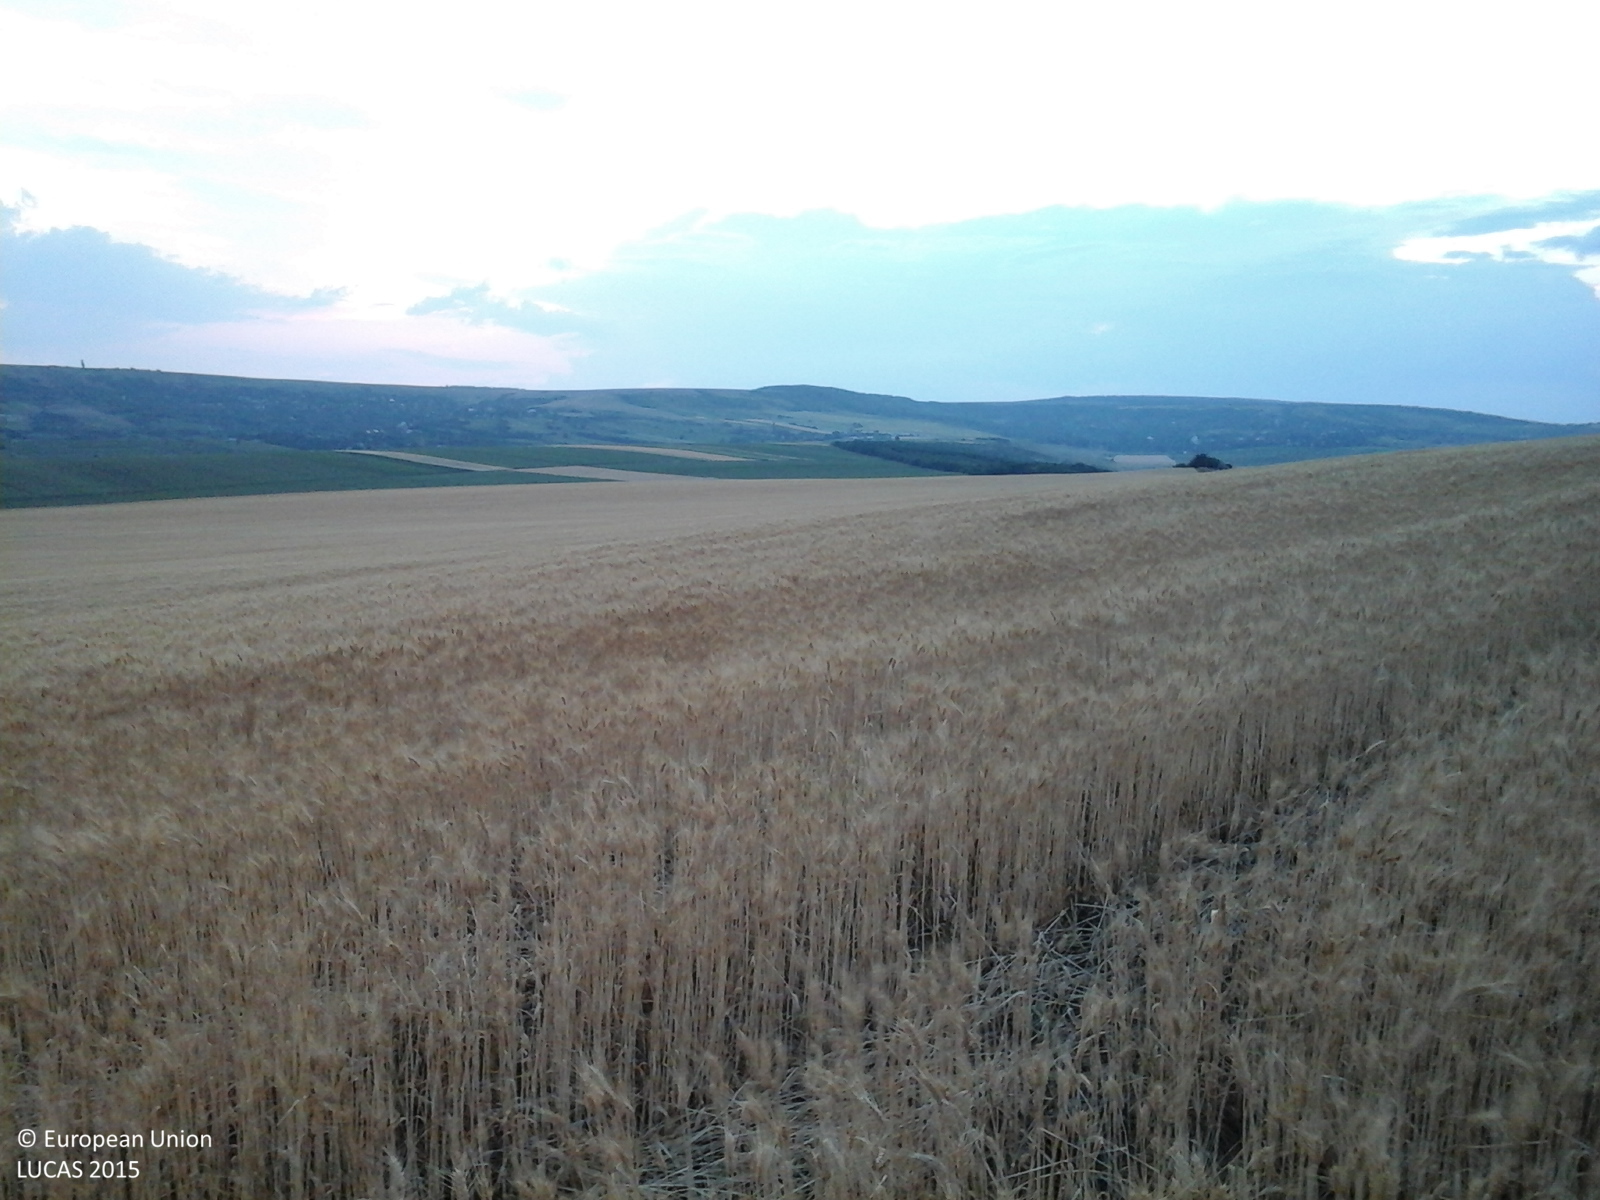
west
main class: Cropland
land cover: Common wheat
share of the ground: > 75 %
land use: Agriculture (excluding fallow land and kitchen gardens)
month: June
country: RO
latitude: 46.7880
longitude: 28.0641
